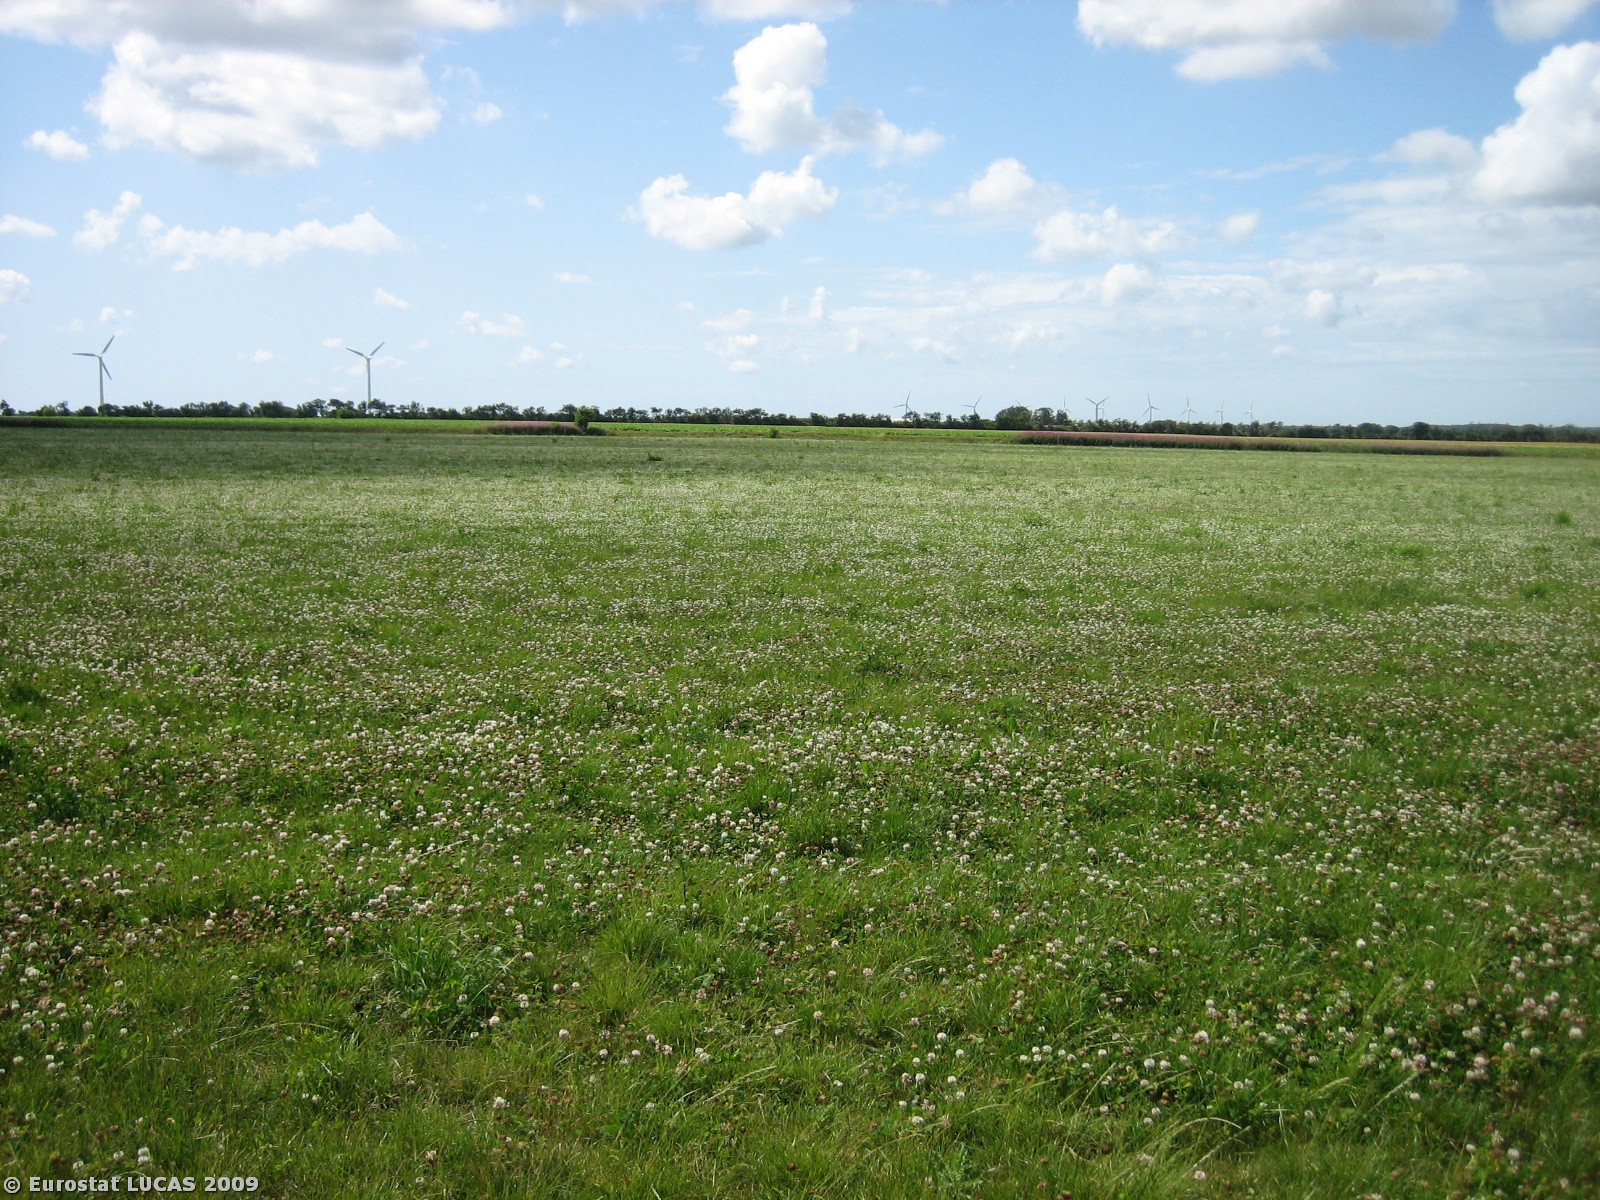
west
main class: Cropland
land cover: Rape and turnip rape
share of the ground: > 75 %
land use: Agriculture (excluding fallow land and kitchen gardens)
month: July
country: DK
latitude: 55.8013
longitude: 8.4860
